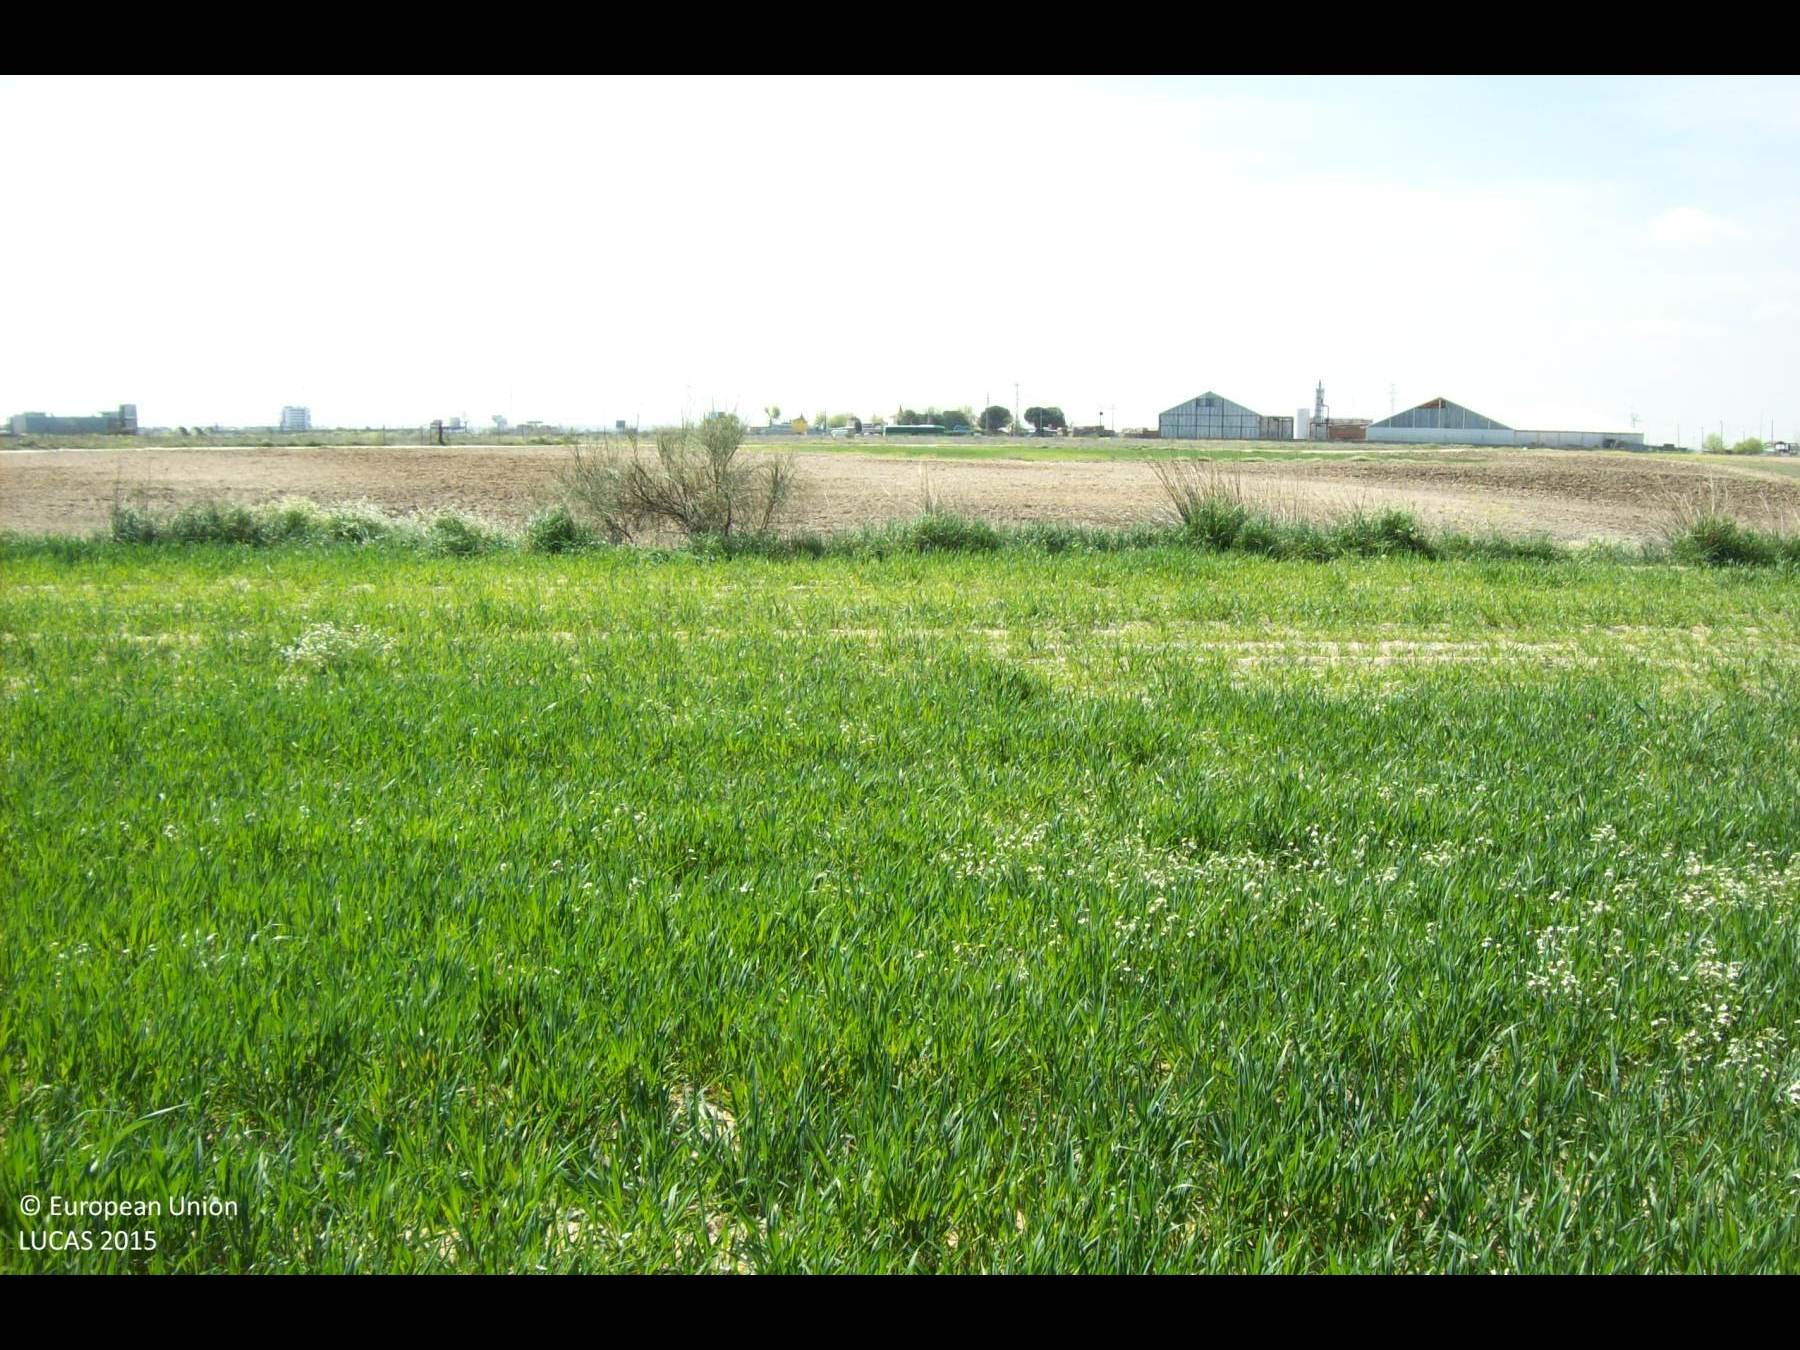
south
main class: Cropland
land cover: Barley
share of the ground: > 75 %
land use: Agriculture (excluding fallow land and kitchen gardens)
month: April
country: ES
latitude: 40.3607
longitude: -3.8514
